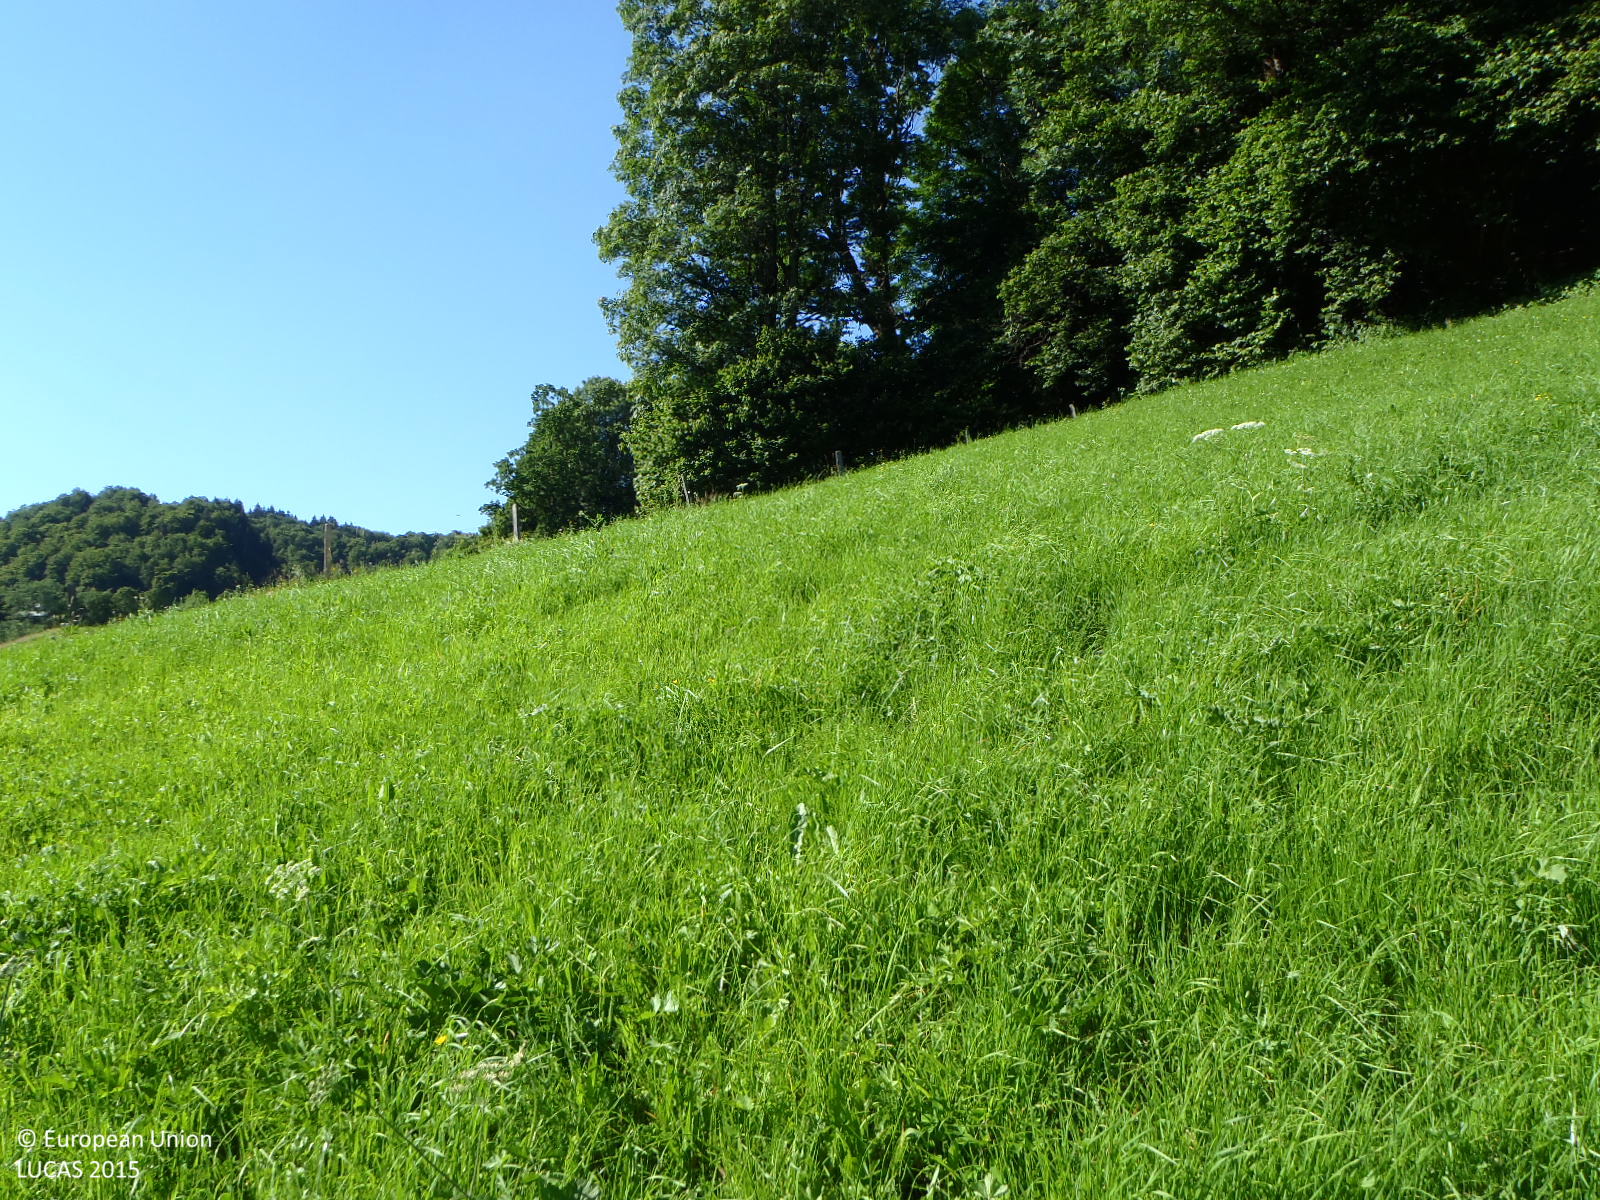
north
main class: Grassland
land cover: Grassland without tree/shrub cover
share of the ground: > 75 %
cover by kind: herbaceous plants 100 %
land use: Agriculture (excluding fallow land and kitchen gardens)
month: July
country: AT
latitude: 47.4226
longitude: 12.4241
